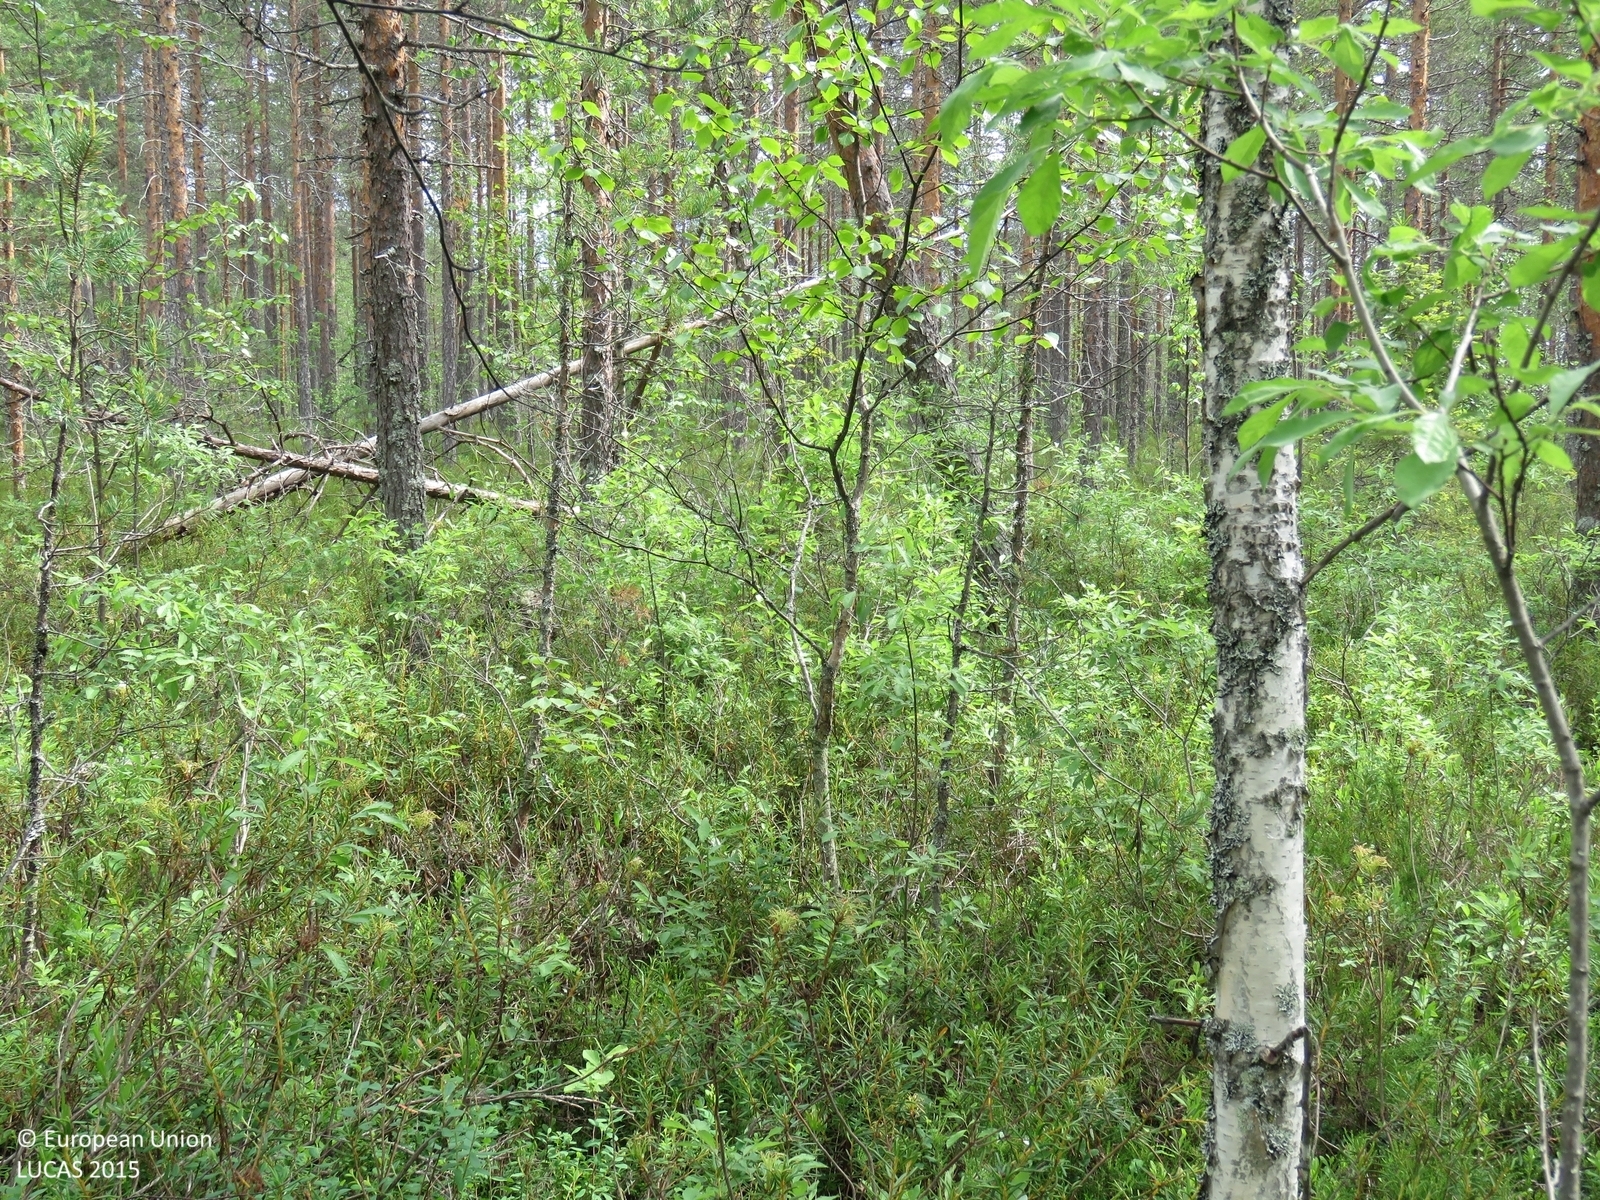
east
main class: Woodland
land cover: Pine dominated mixed woodland
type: boreal forest
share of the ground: > 75 %
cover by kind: coniferous forest trees 50 %, broadleaved forest trees 30 %, shrubs 20 %
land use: Forestry
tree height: > 5 m
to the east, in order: Pine dominated mixed woodland; Pine dominated coniferous woodland; Ditches and canals; Pine dominated coniferous woodland; Ditches and canals; Pine dominated coniferous woodland; Ditches and canals; Pine dominated coniferous woodland; Ditches and canals; Pine dominated coniferous woodland
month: July
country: FI
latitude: 64.2206
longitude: 26.5865
